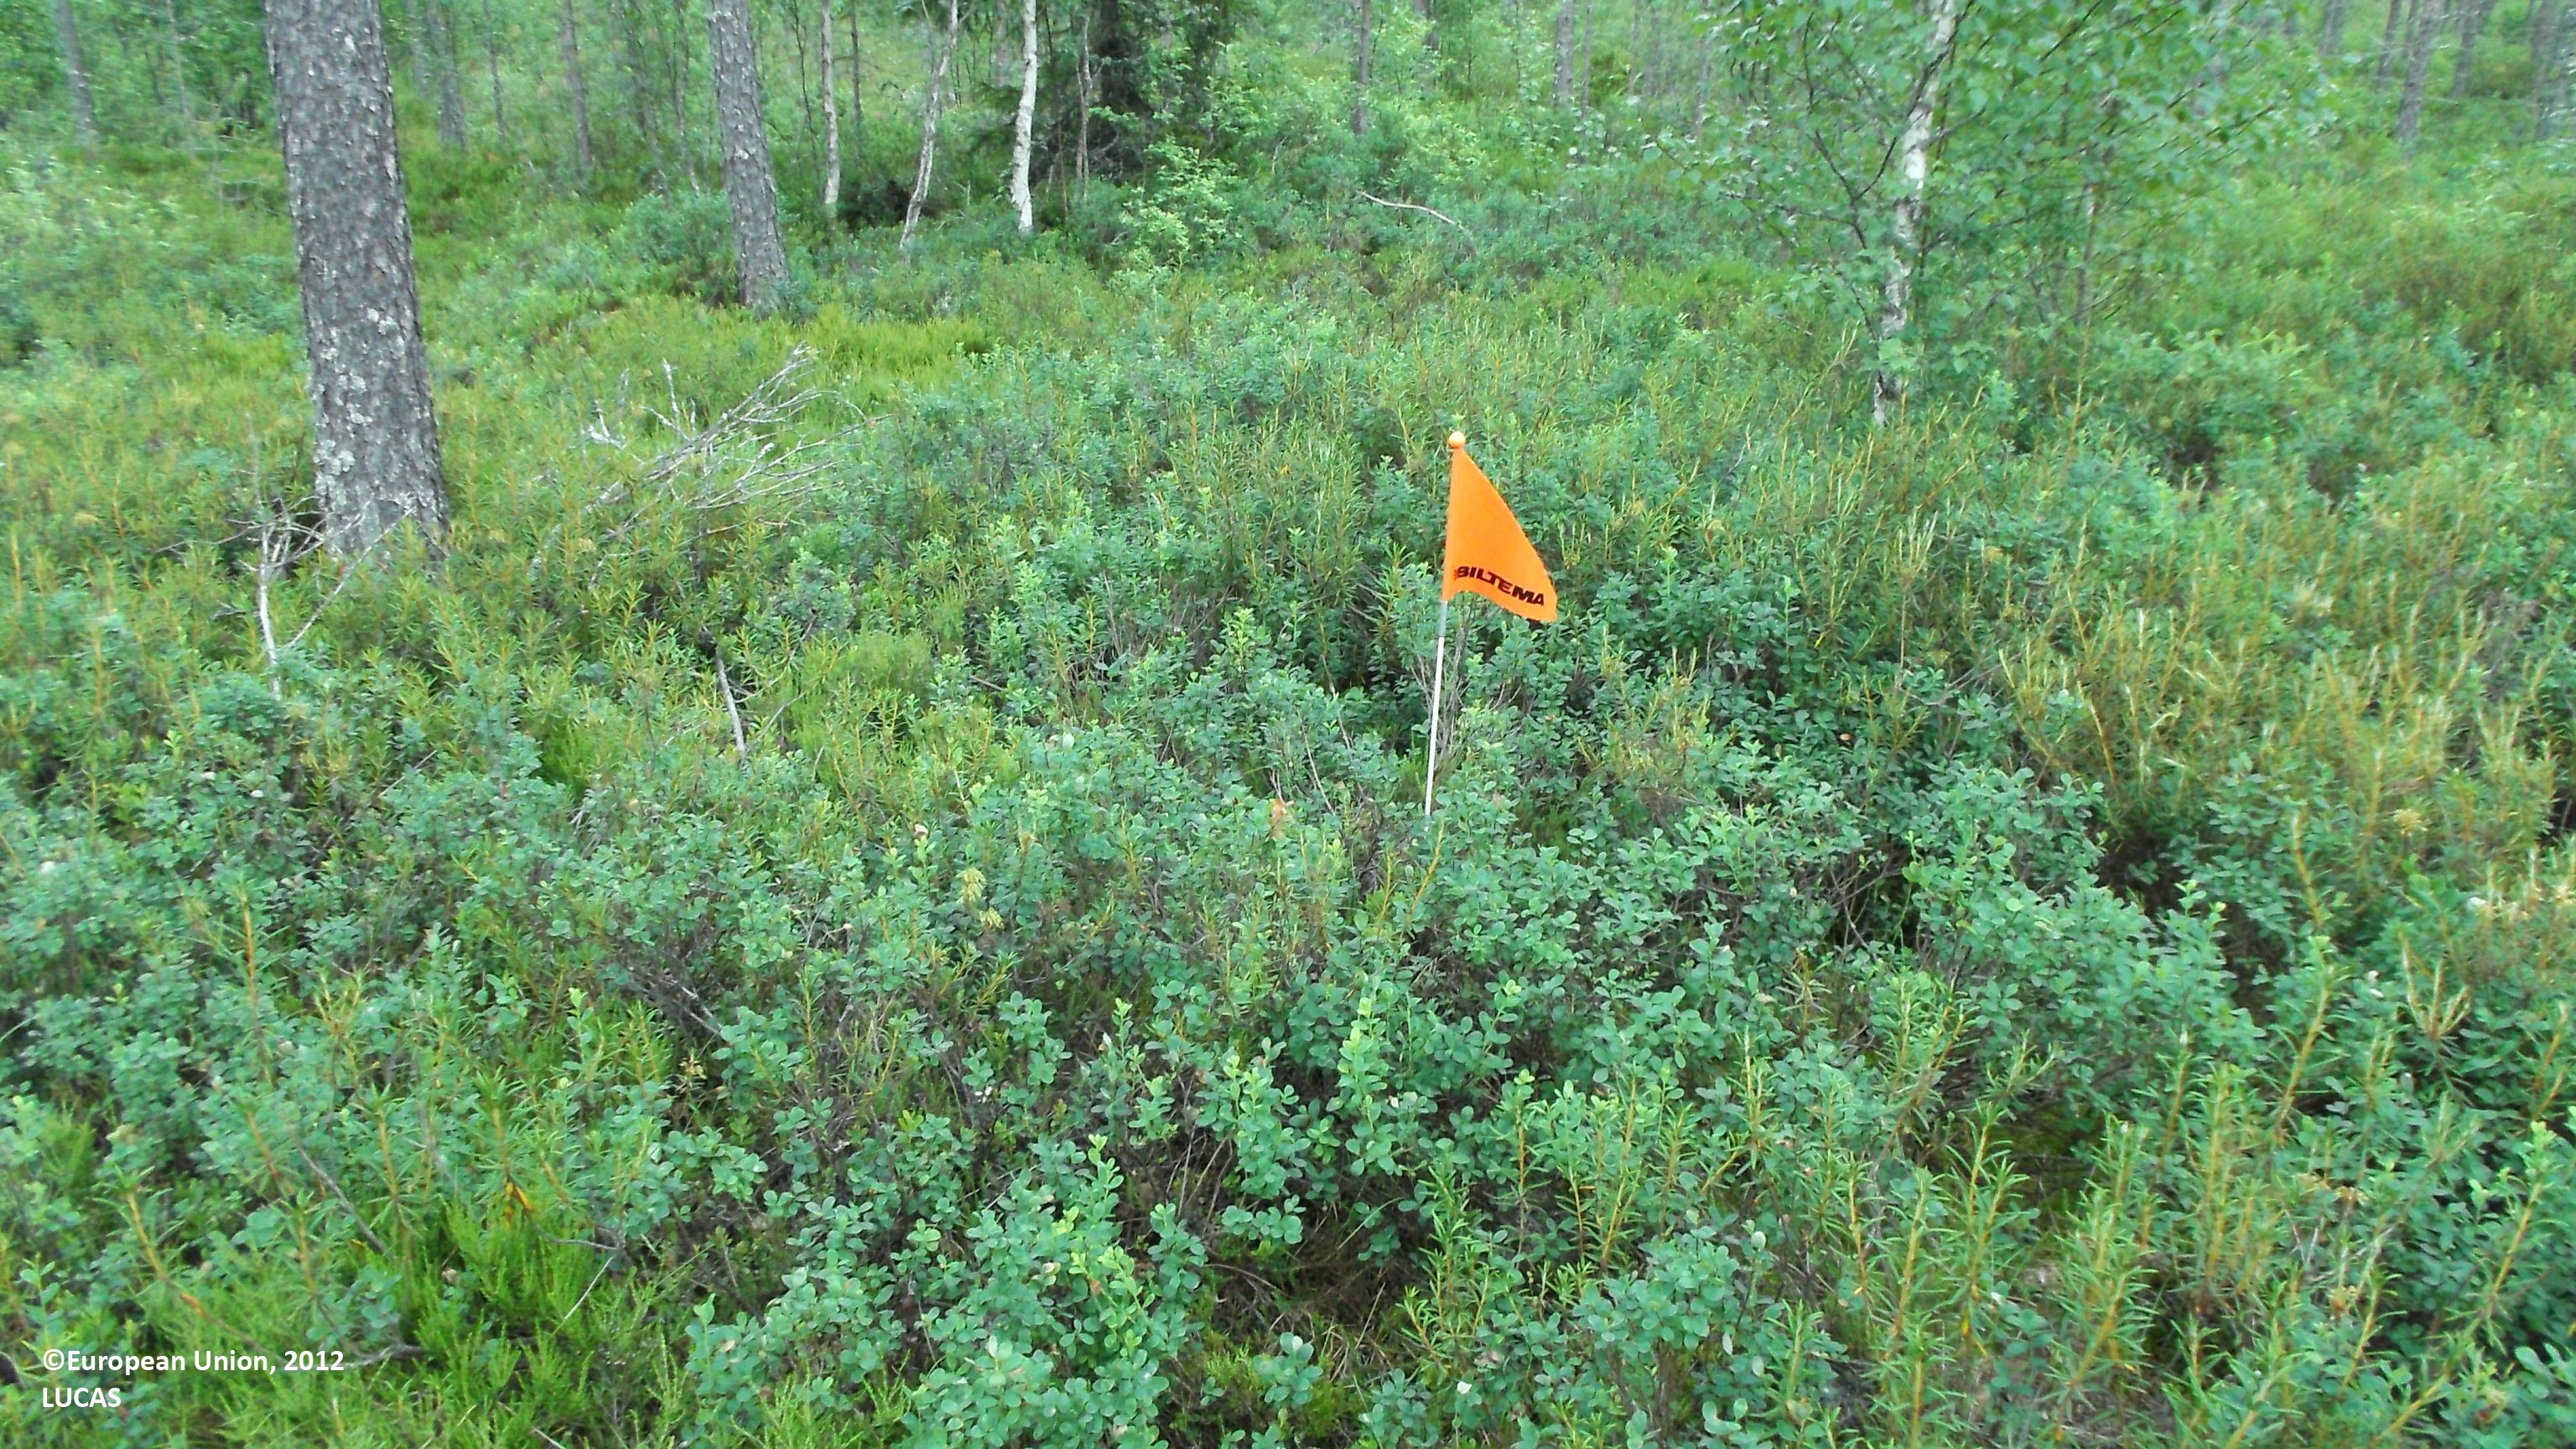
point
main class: Woodland
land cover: Pine dominated mixed woodland
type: boreal forest
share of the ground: 10 - 25 %
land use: Forestry
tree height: > 5 m
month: July
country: FI
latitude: 63.2658
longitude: 23.5137
